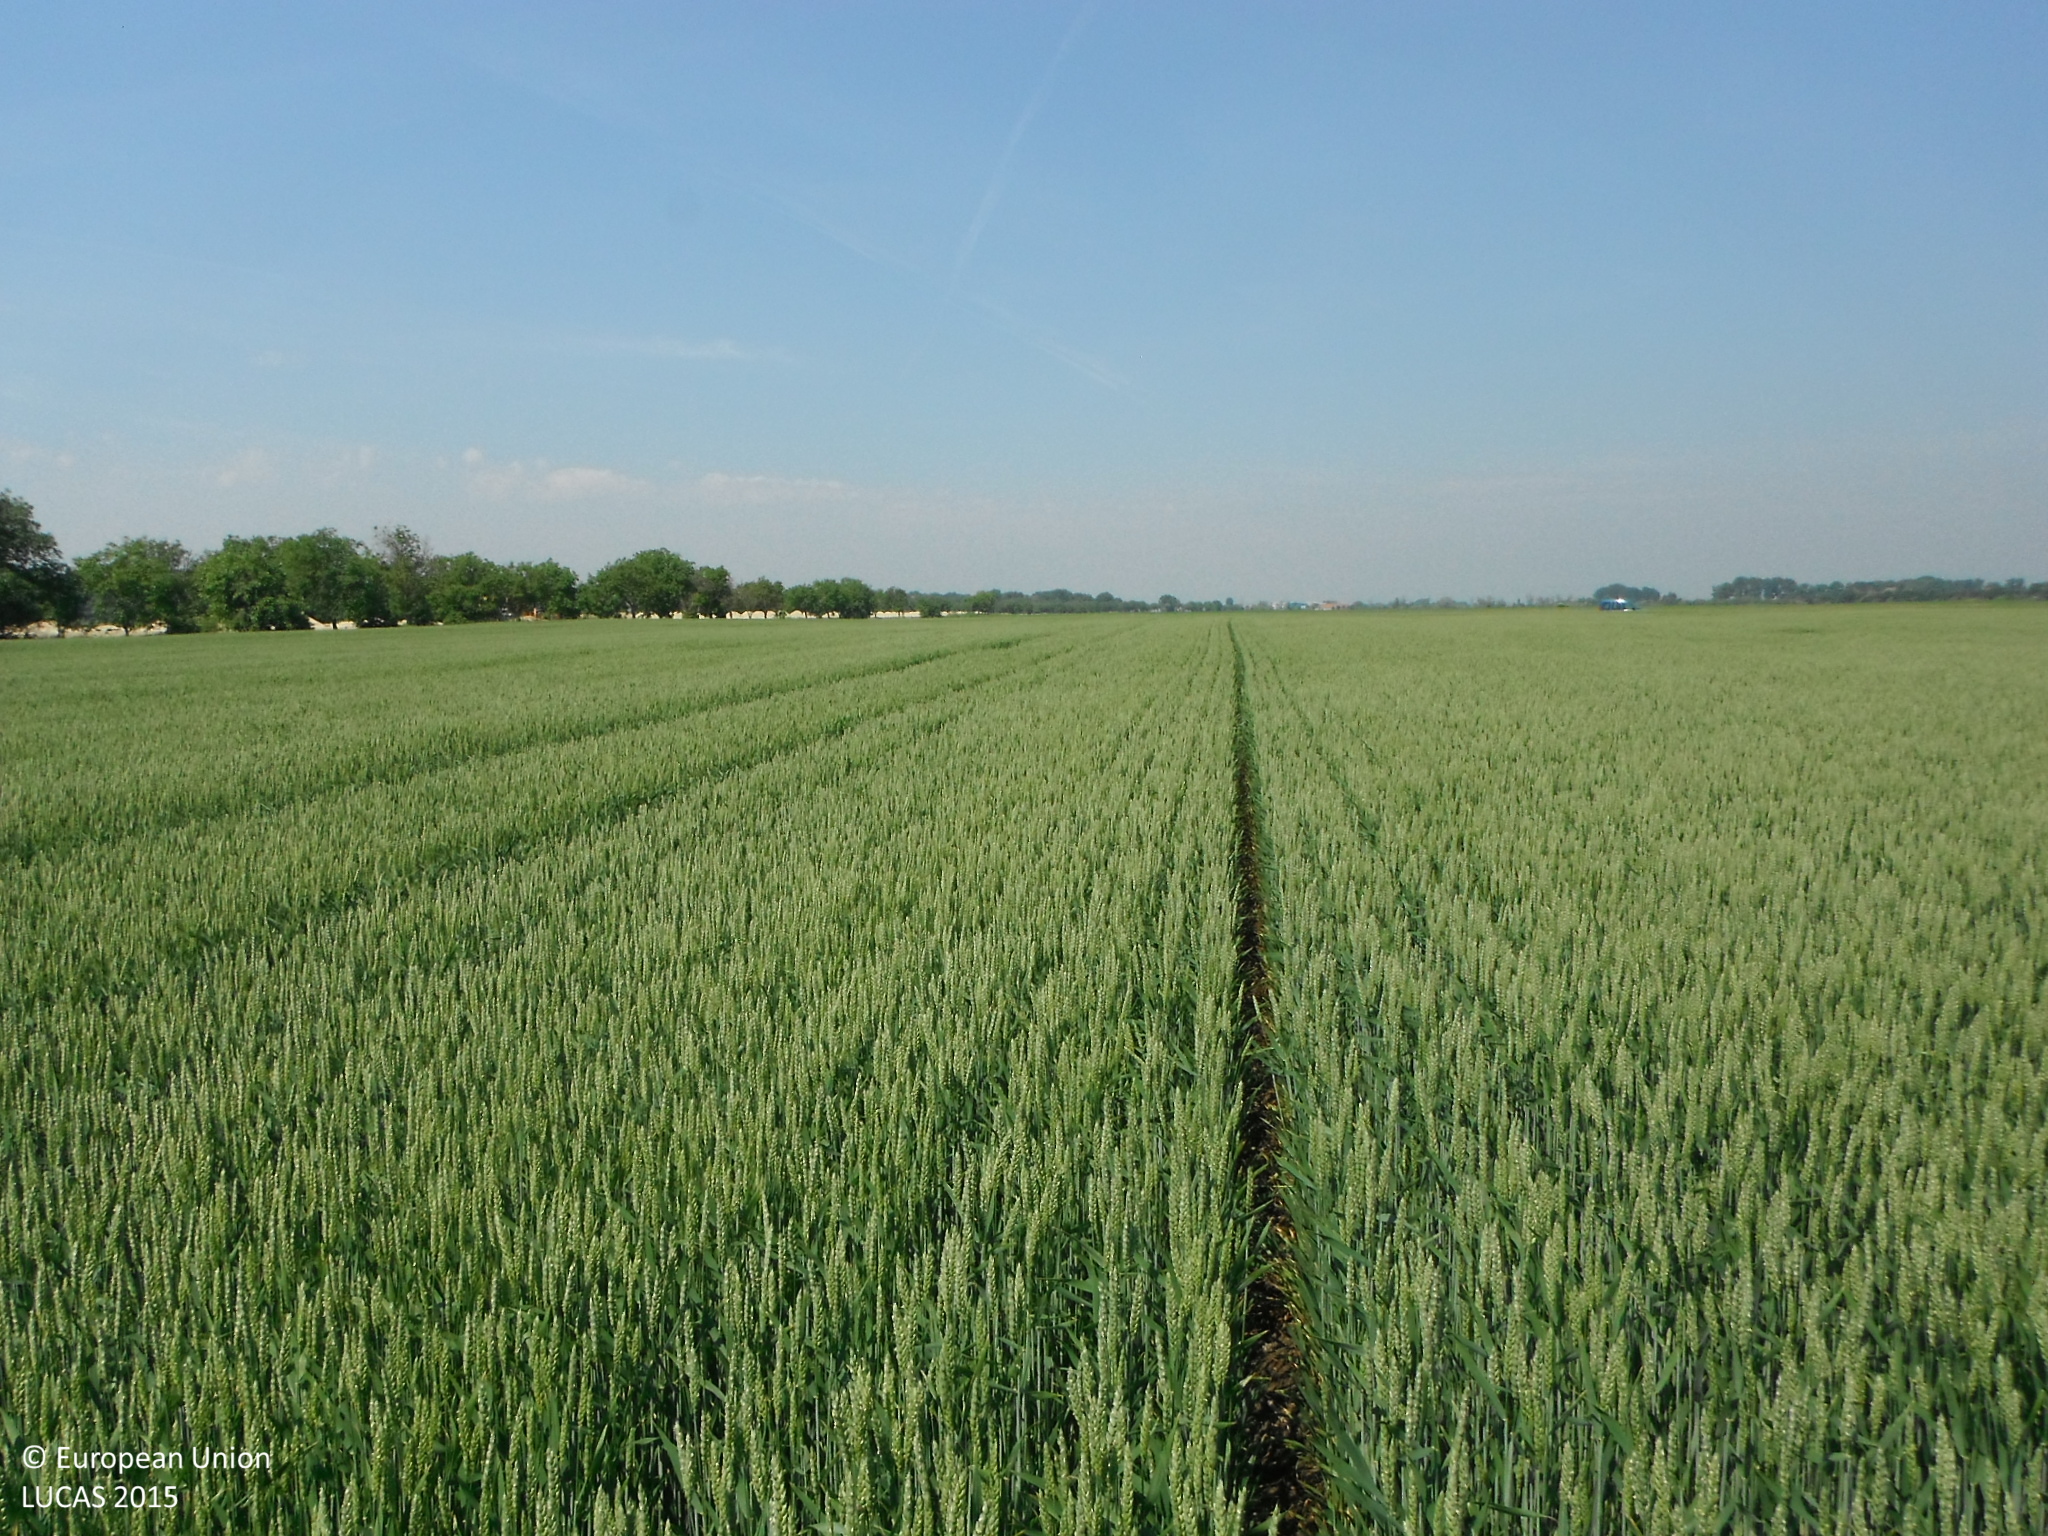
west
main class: Cropland
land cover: Common wheat
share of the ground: > 75 %
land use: Agriculture (excluding fallow land and kitchen gardens)
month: May
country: SK
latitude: 48.1970
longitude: 17.5849
